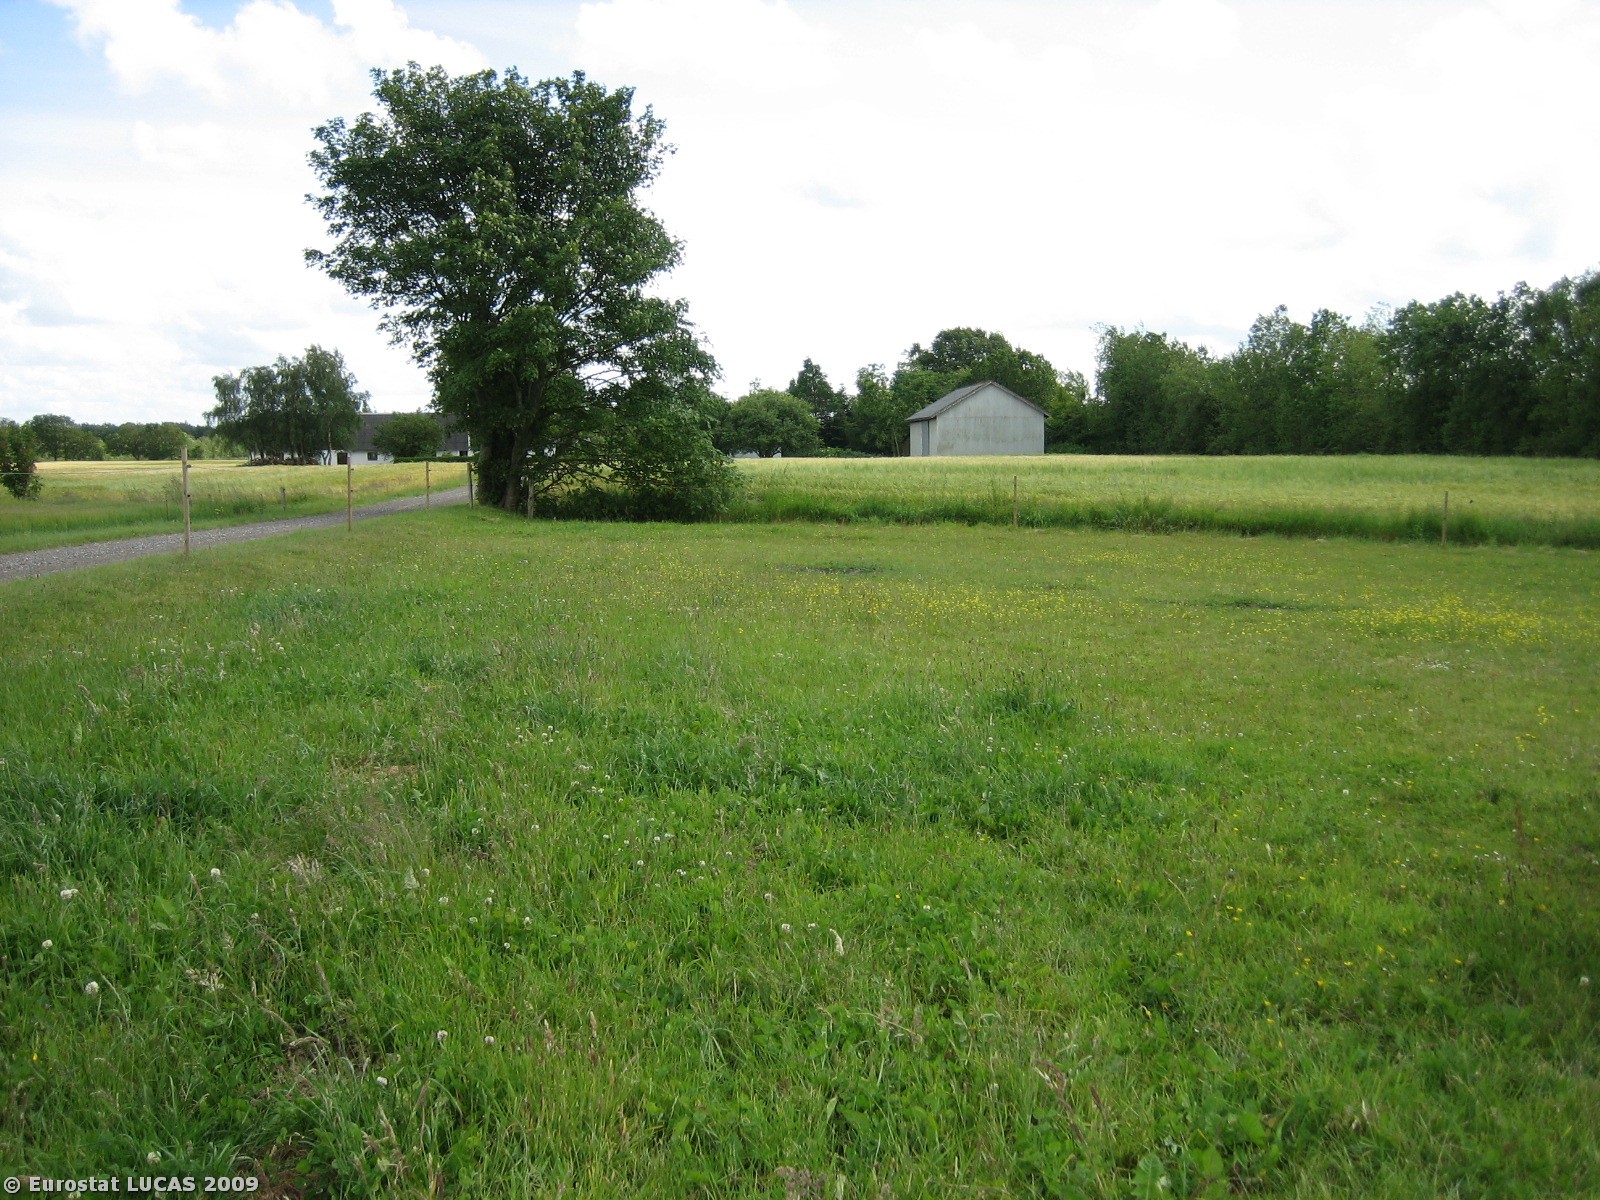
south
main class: Grassland
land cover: Grassland without tree/shrub cover
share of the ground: > 75 %
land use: Agriculture (excluding fallow land and kitchen gardens)
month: June
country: DK
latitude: 55.6285
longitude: 9.2860
